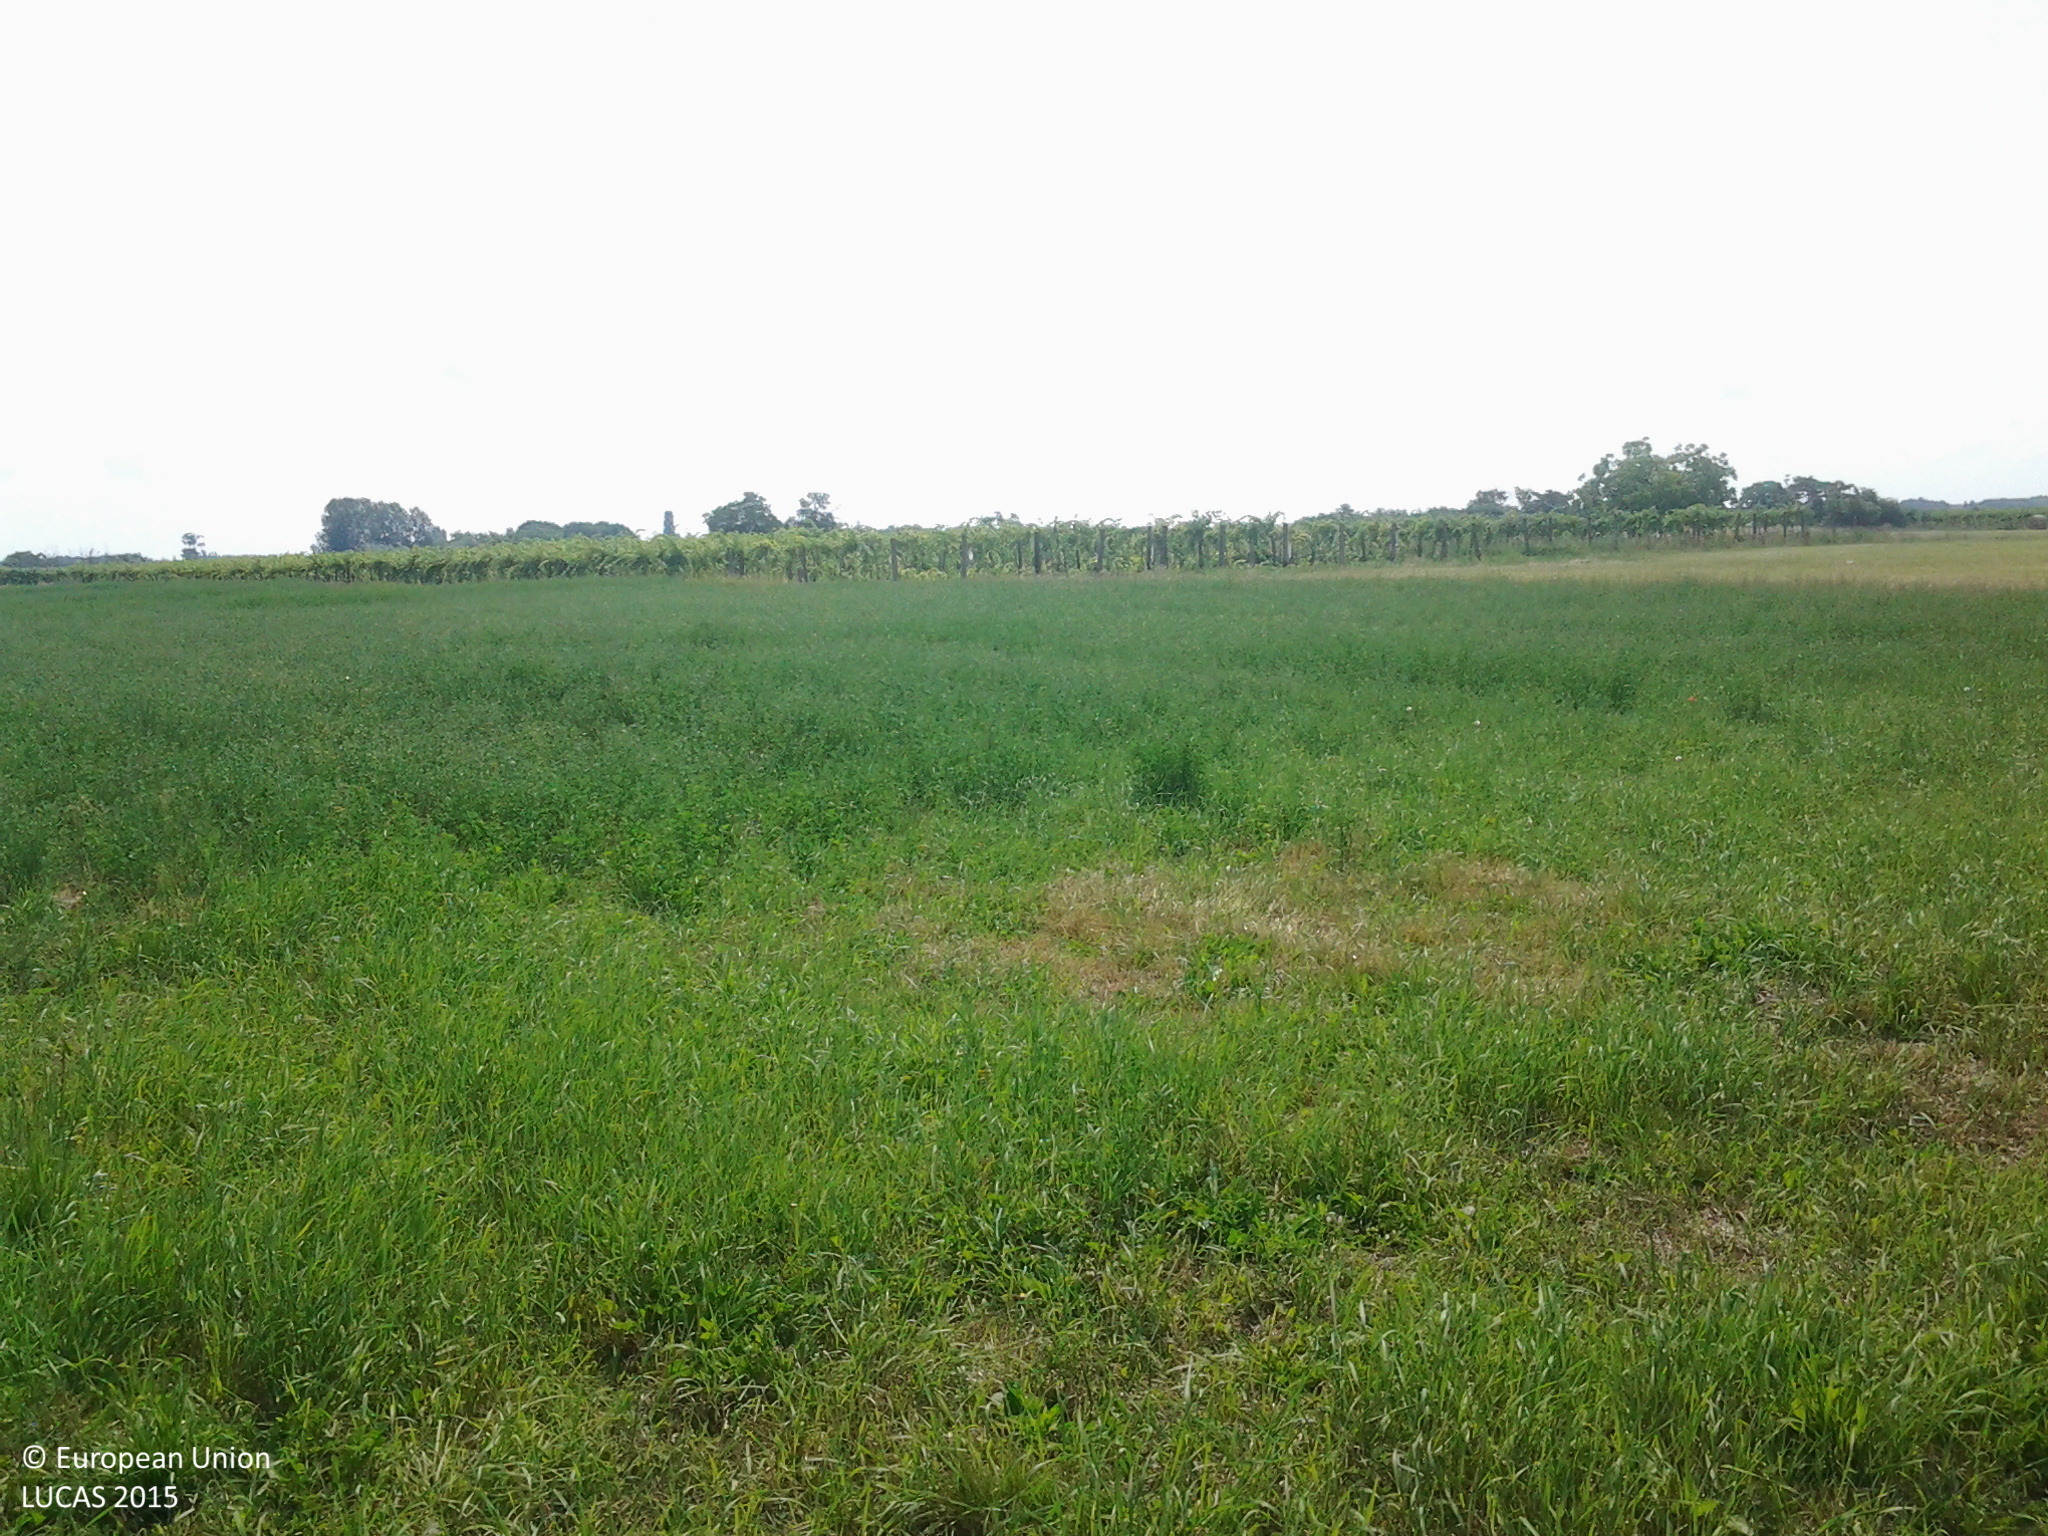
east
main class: Grassland
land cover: Grassland without tree/shrub cover
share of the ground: > 75 %
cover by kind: herbaceous plants 100 %
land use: Agriculture (excluding fallow land and kitchen gardens)
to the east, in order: Grassland without tree/shrub cover; Lucerne; Barley; Tracks; Vineyards
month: June
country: HU
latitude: 46.7631
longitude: 19.2738
